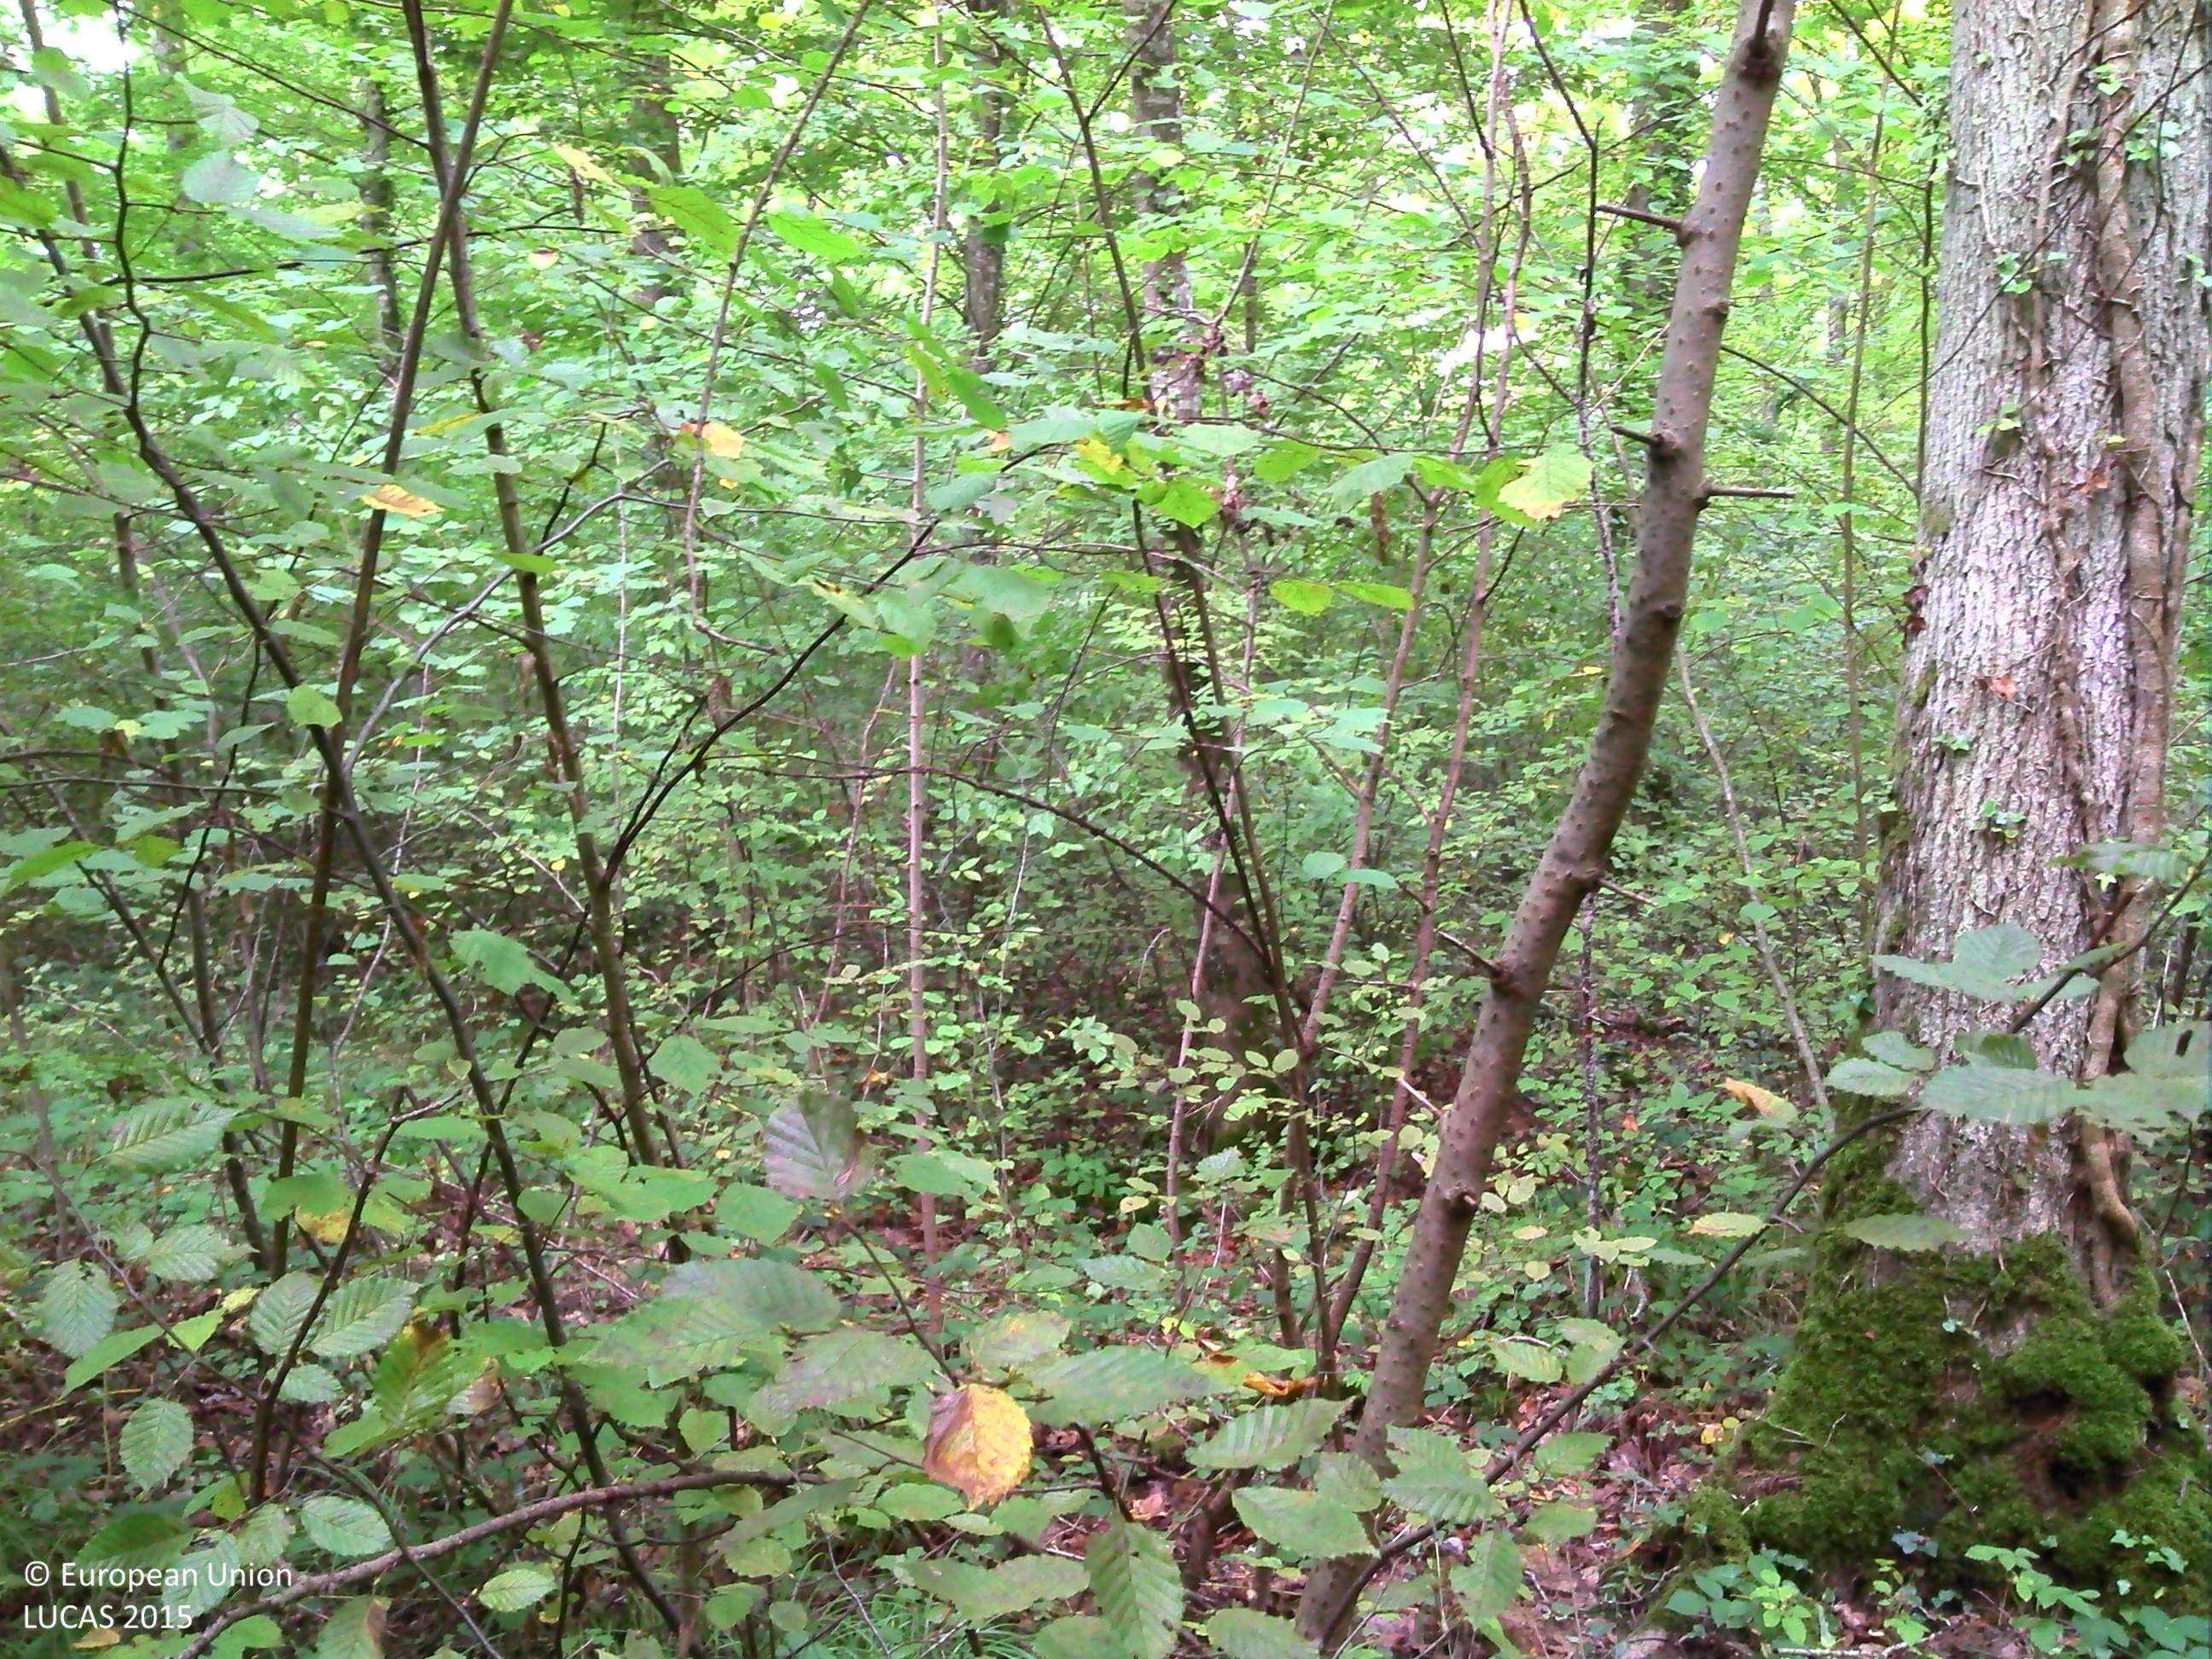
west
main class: Woodland
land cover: Broadleaved woodland
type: mesophytic deciduous forest
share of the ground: > 75 %
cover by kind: broadleaved forest trees 80 %, shrubs 10 %, herbaceous plants 5 %, lichens and mosses 5 %
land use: Forestry
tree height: > 5 m
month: September
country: FR
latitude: 48.3265
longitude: 4.6162
